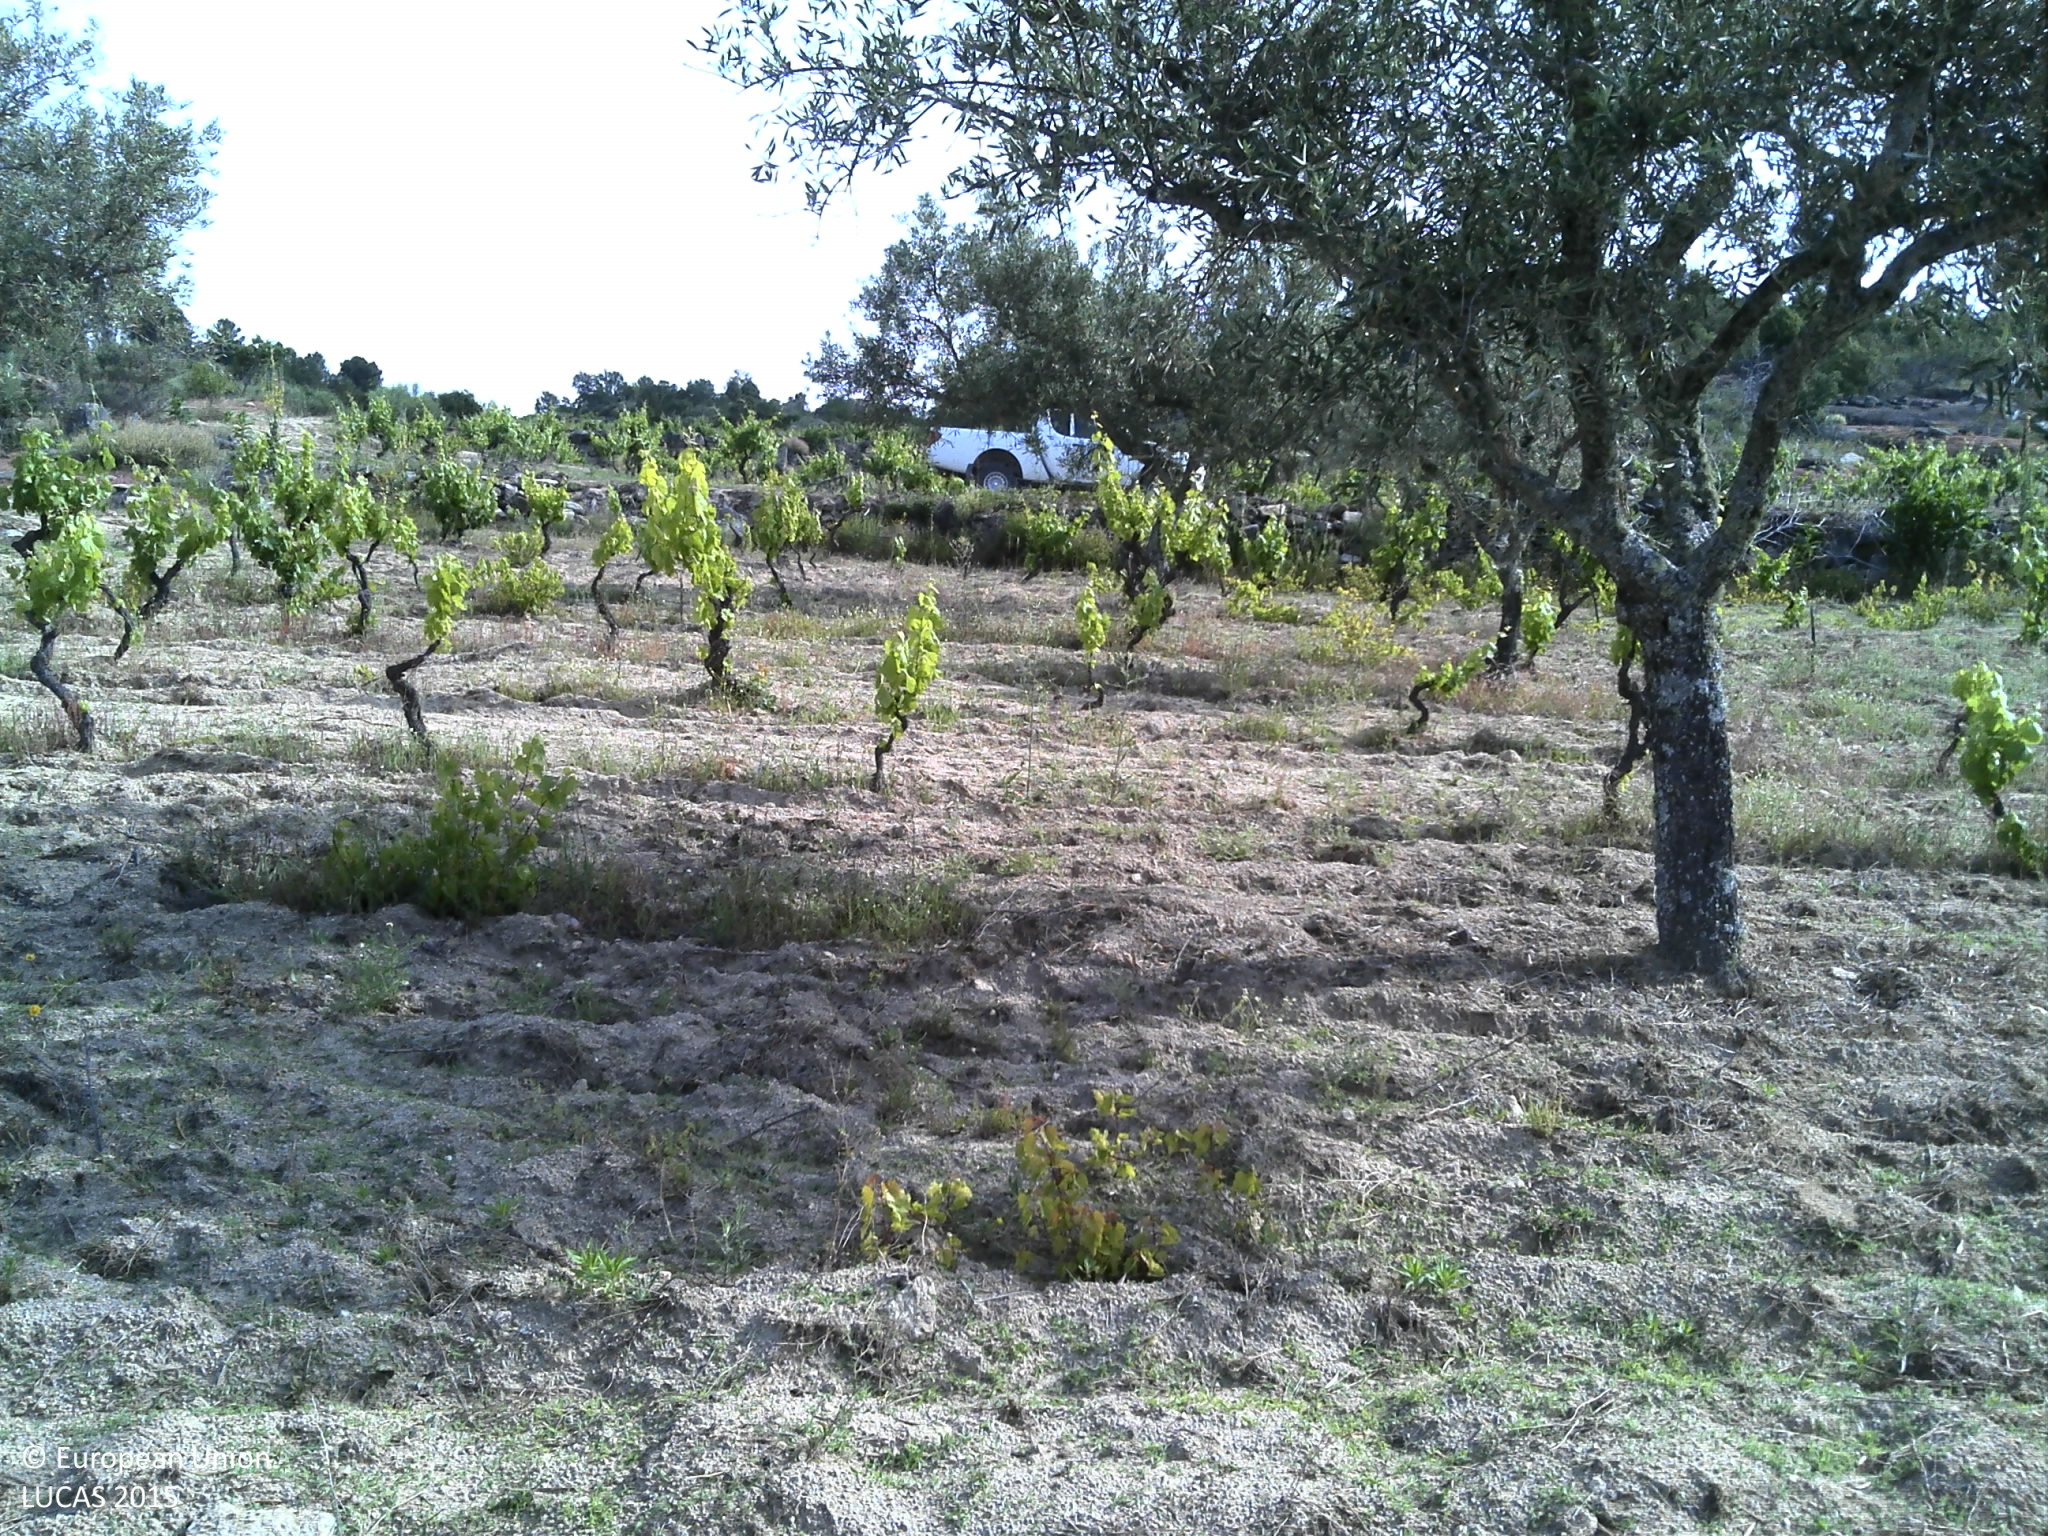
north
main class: Cropland
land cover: Vineyards
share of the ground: < 10 %
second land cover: Olive groves
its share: < 10 %
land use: Agriculture (excluding fallow land and kitchen gardens)
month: May
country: PT
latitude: 41.5783
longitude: -7.2862
